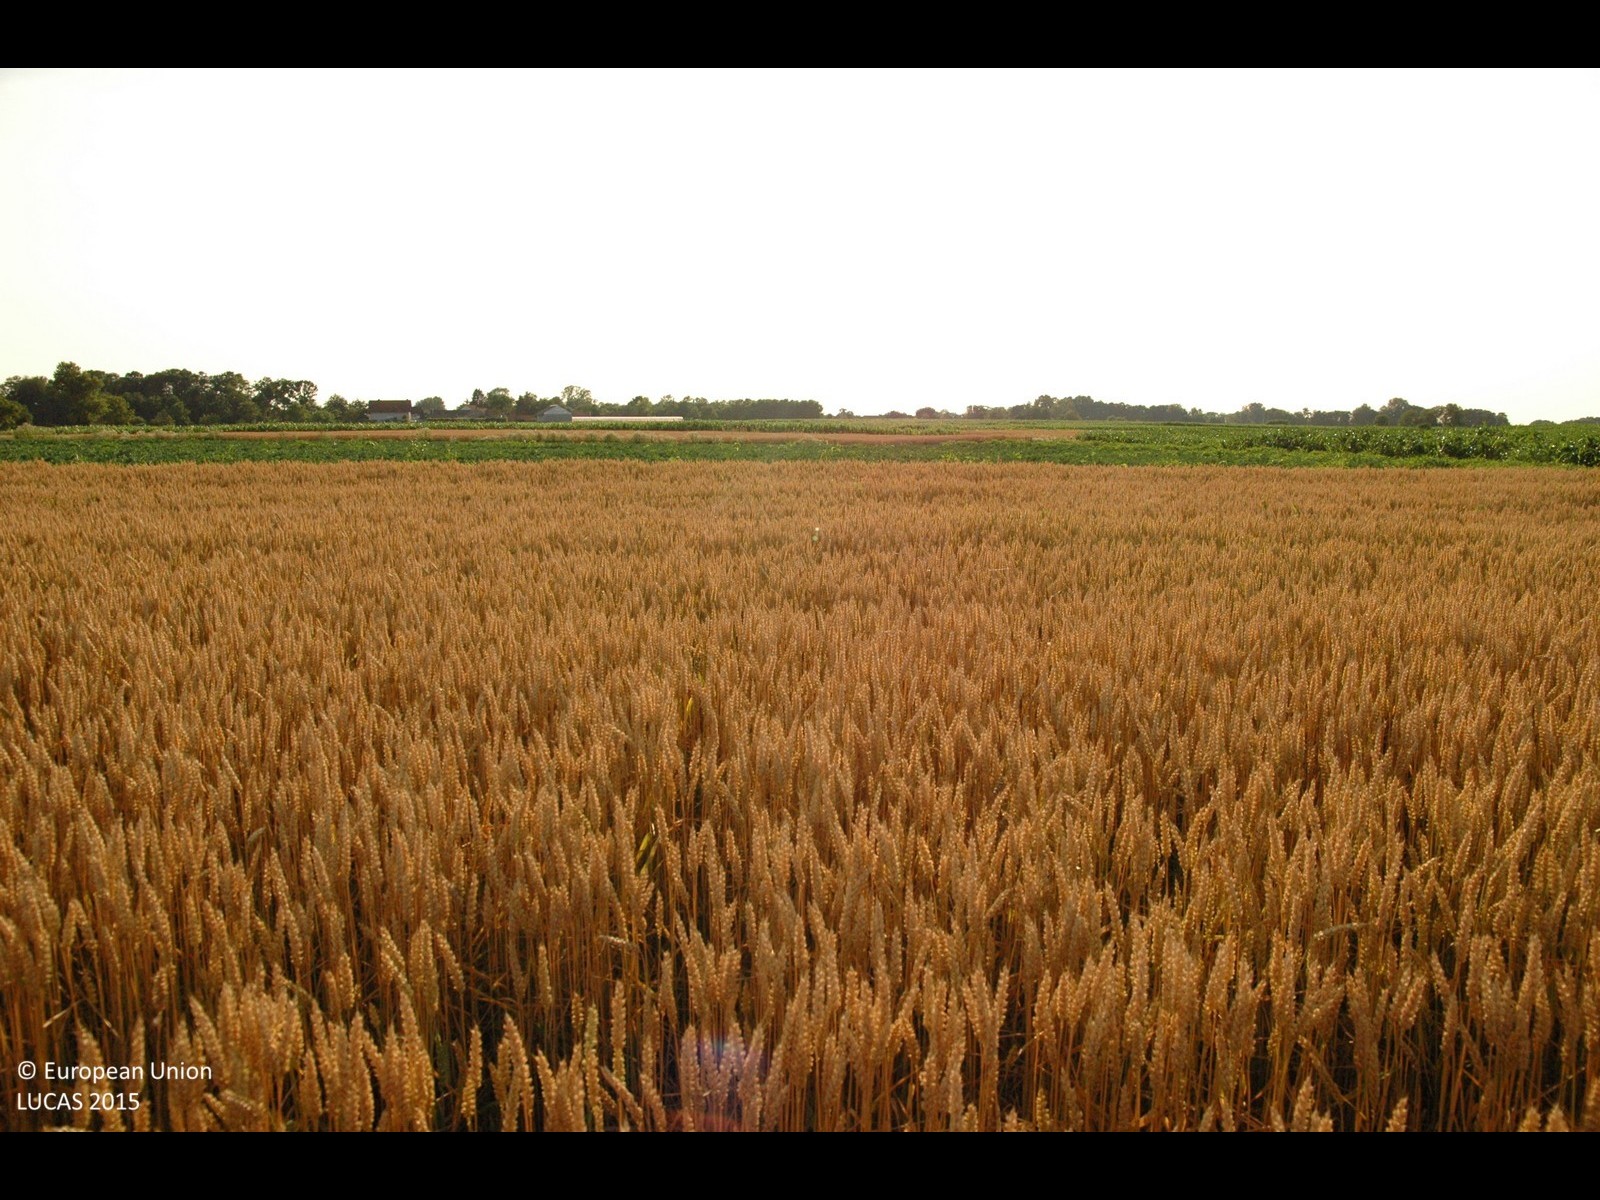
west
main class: Cropland
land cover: Common wheat
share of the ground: > 75 %
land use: Agriculture (excluding fallow land and kitchen gardens)
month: June
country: HR
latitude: 46.3367
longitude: 16.4573
